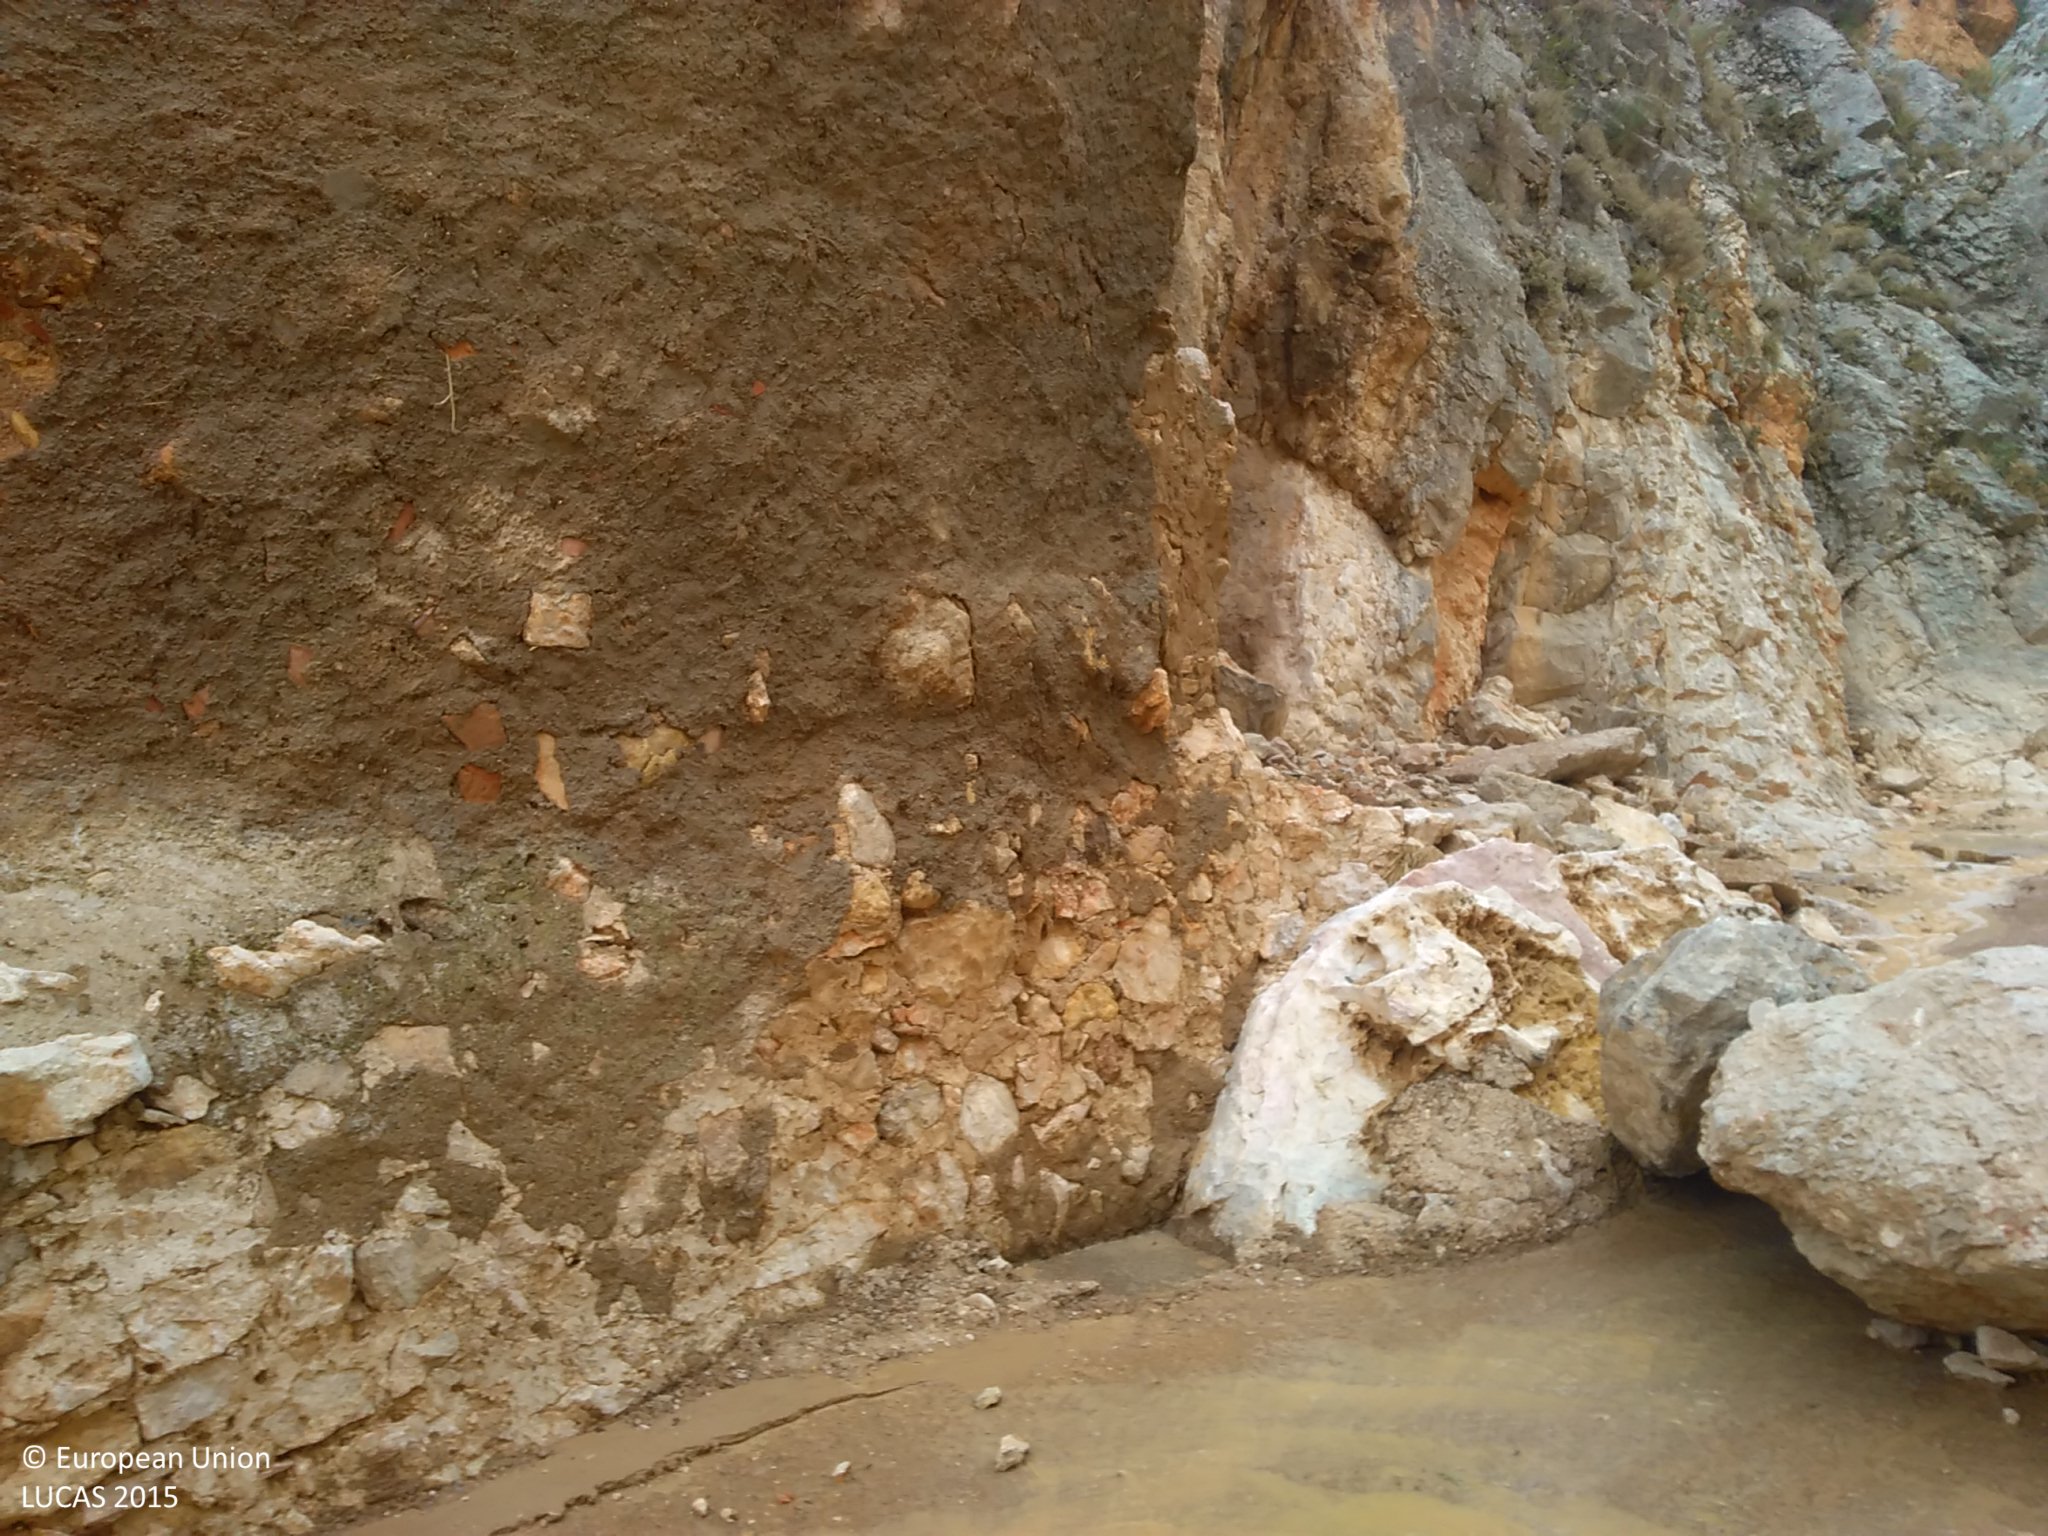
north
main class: Woodland
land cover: Broadleaved woodland
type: broadleaved evergreen forest
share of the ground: 50 - 75 %
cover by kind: broadleaved forest trees 50 %, unconsolidated bare surface 30 %, shrubs 10 %, herbaceous plants 10 %
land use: Semi-natural and natural areas not in use
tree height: < 5 m
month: July
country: ES
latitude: 41.3606
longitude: -1.9462
